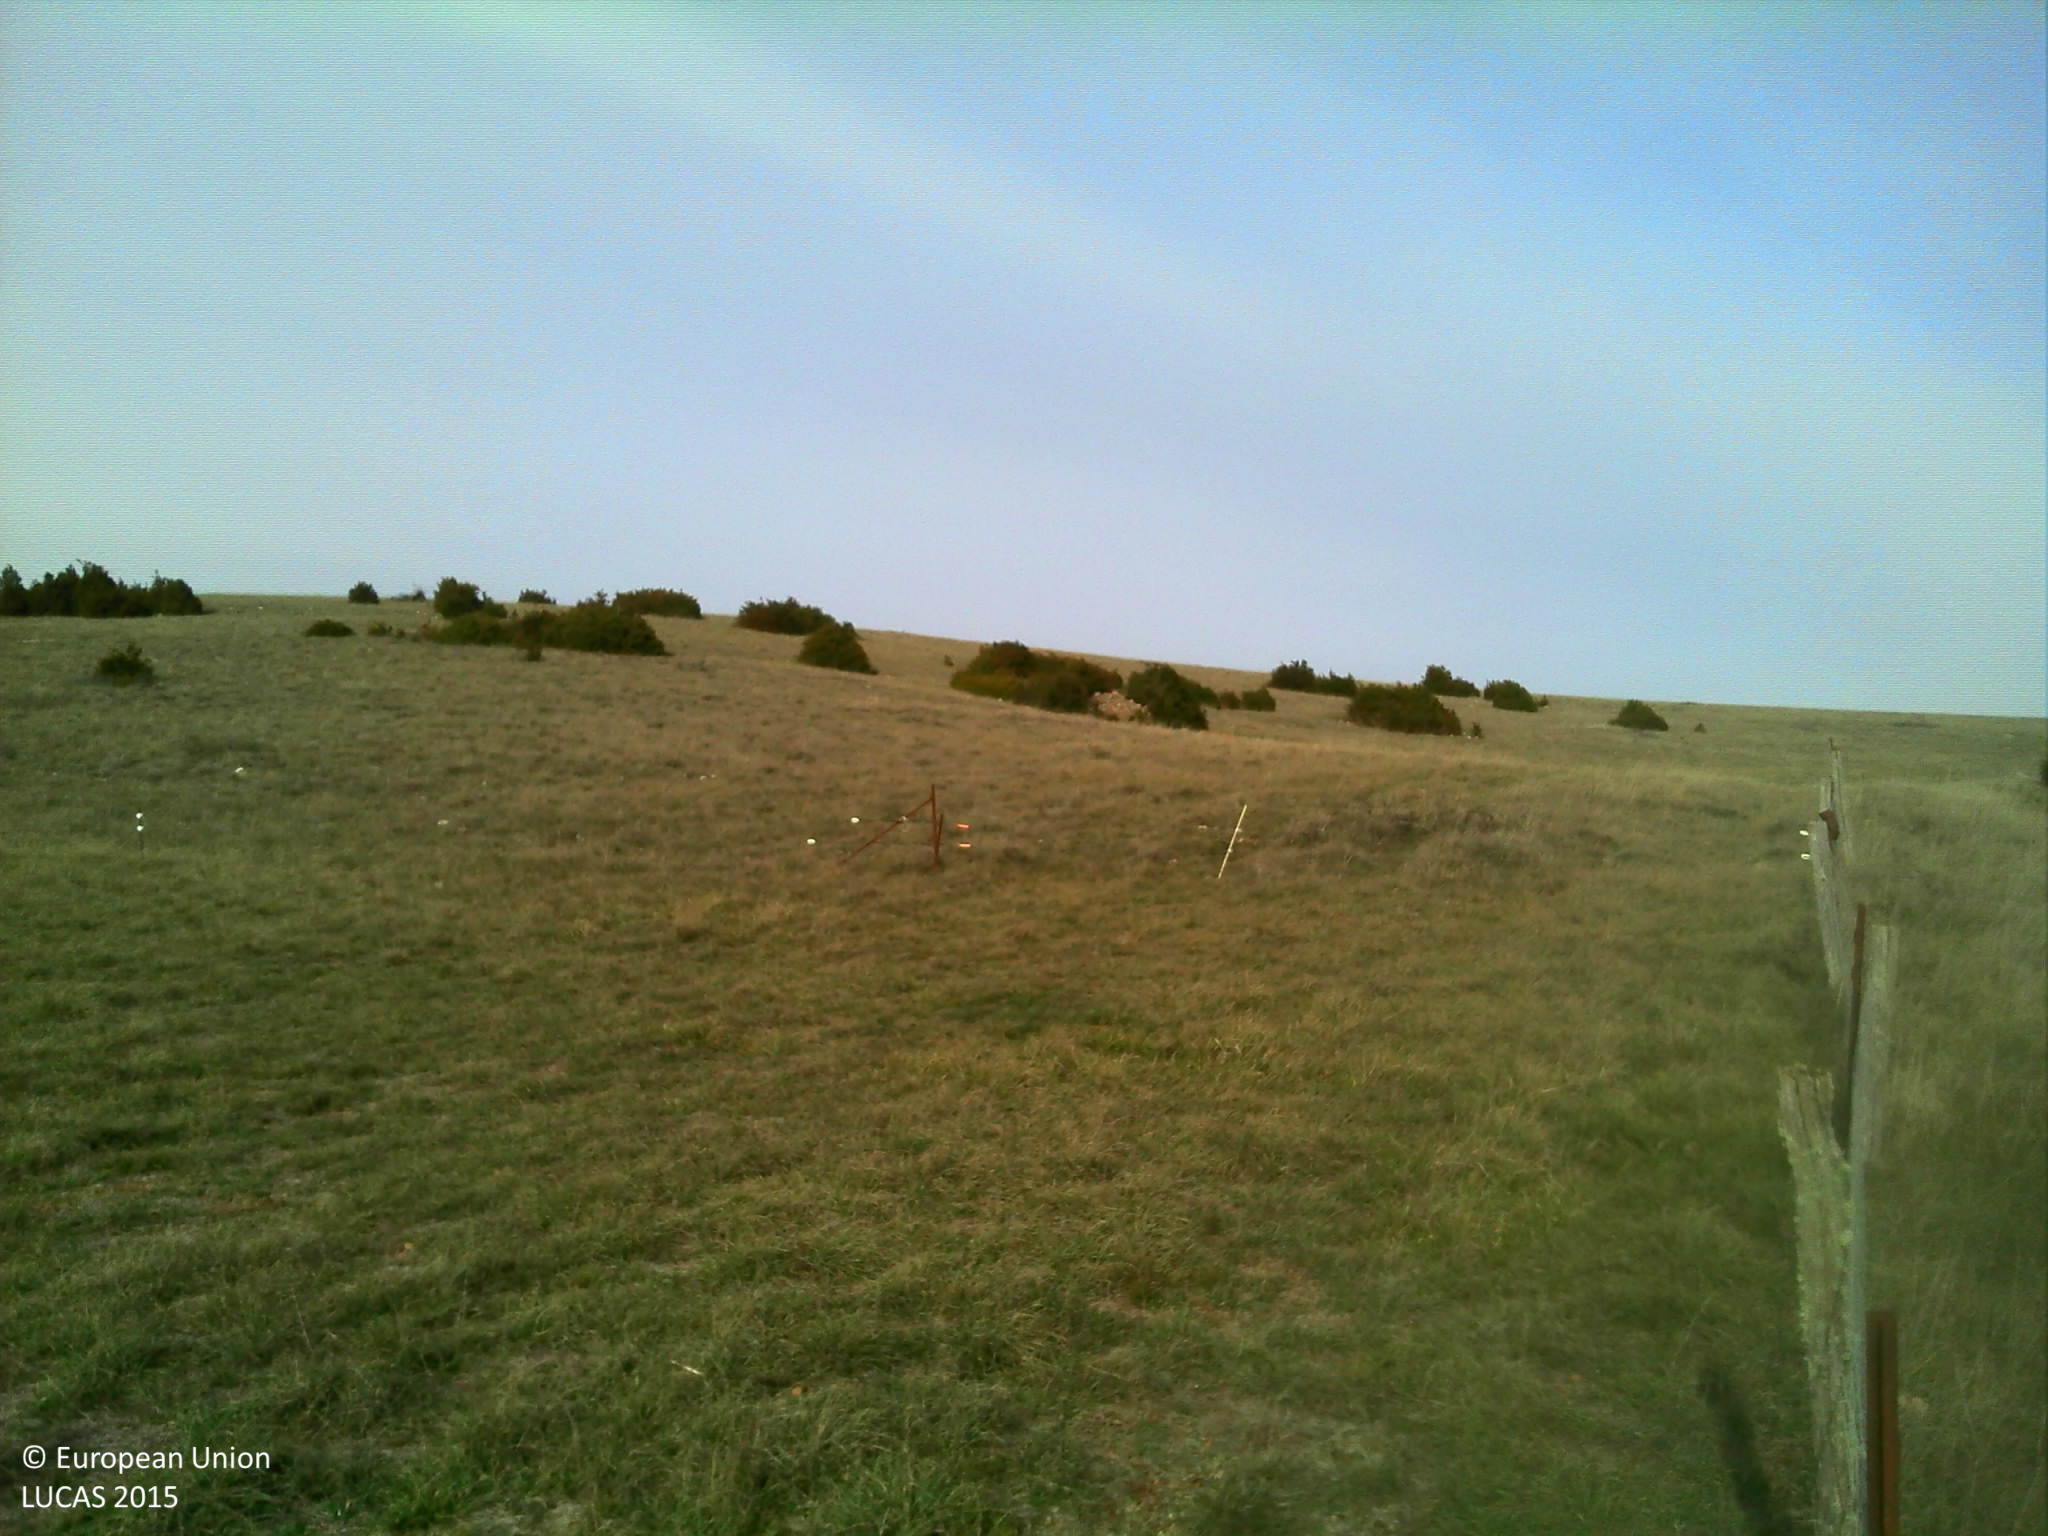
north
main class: Grassland
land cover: Grassland without tree/shrub cover
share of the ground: > 75 %
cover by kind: herbaceous plants 100 %
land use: Agriculture (excluding fallow land and kitchen gardens)
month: November
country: FR
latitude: 44.0649
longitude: 3.0771
